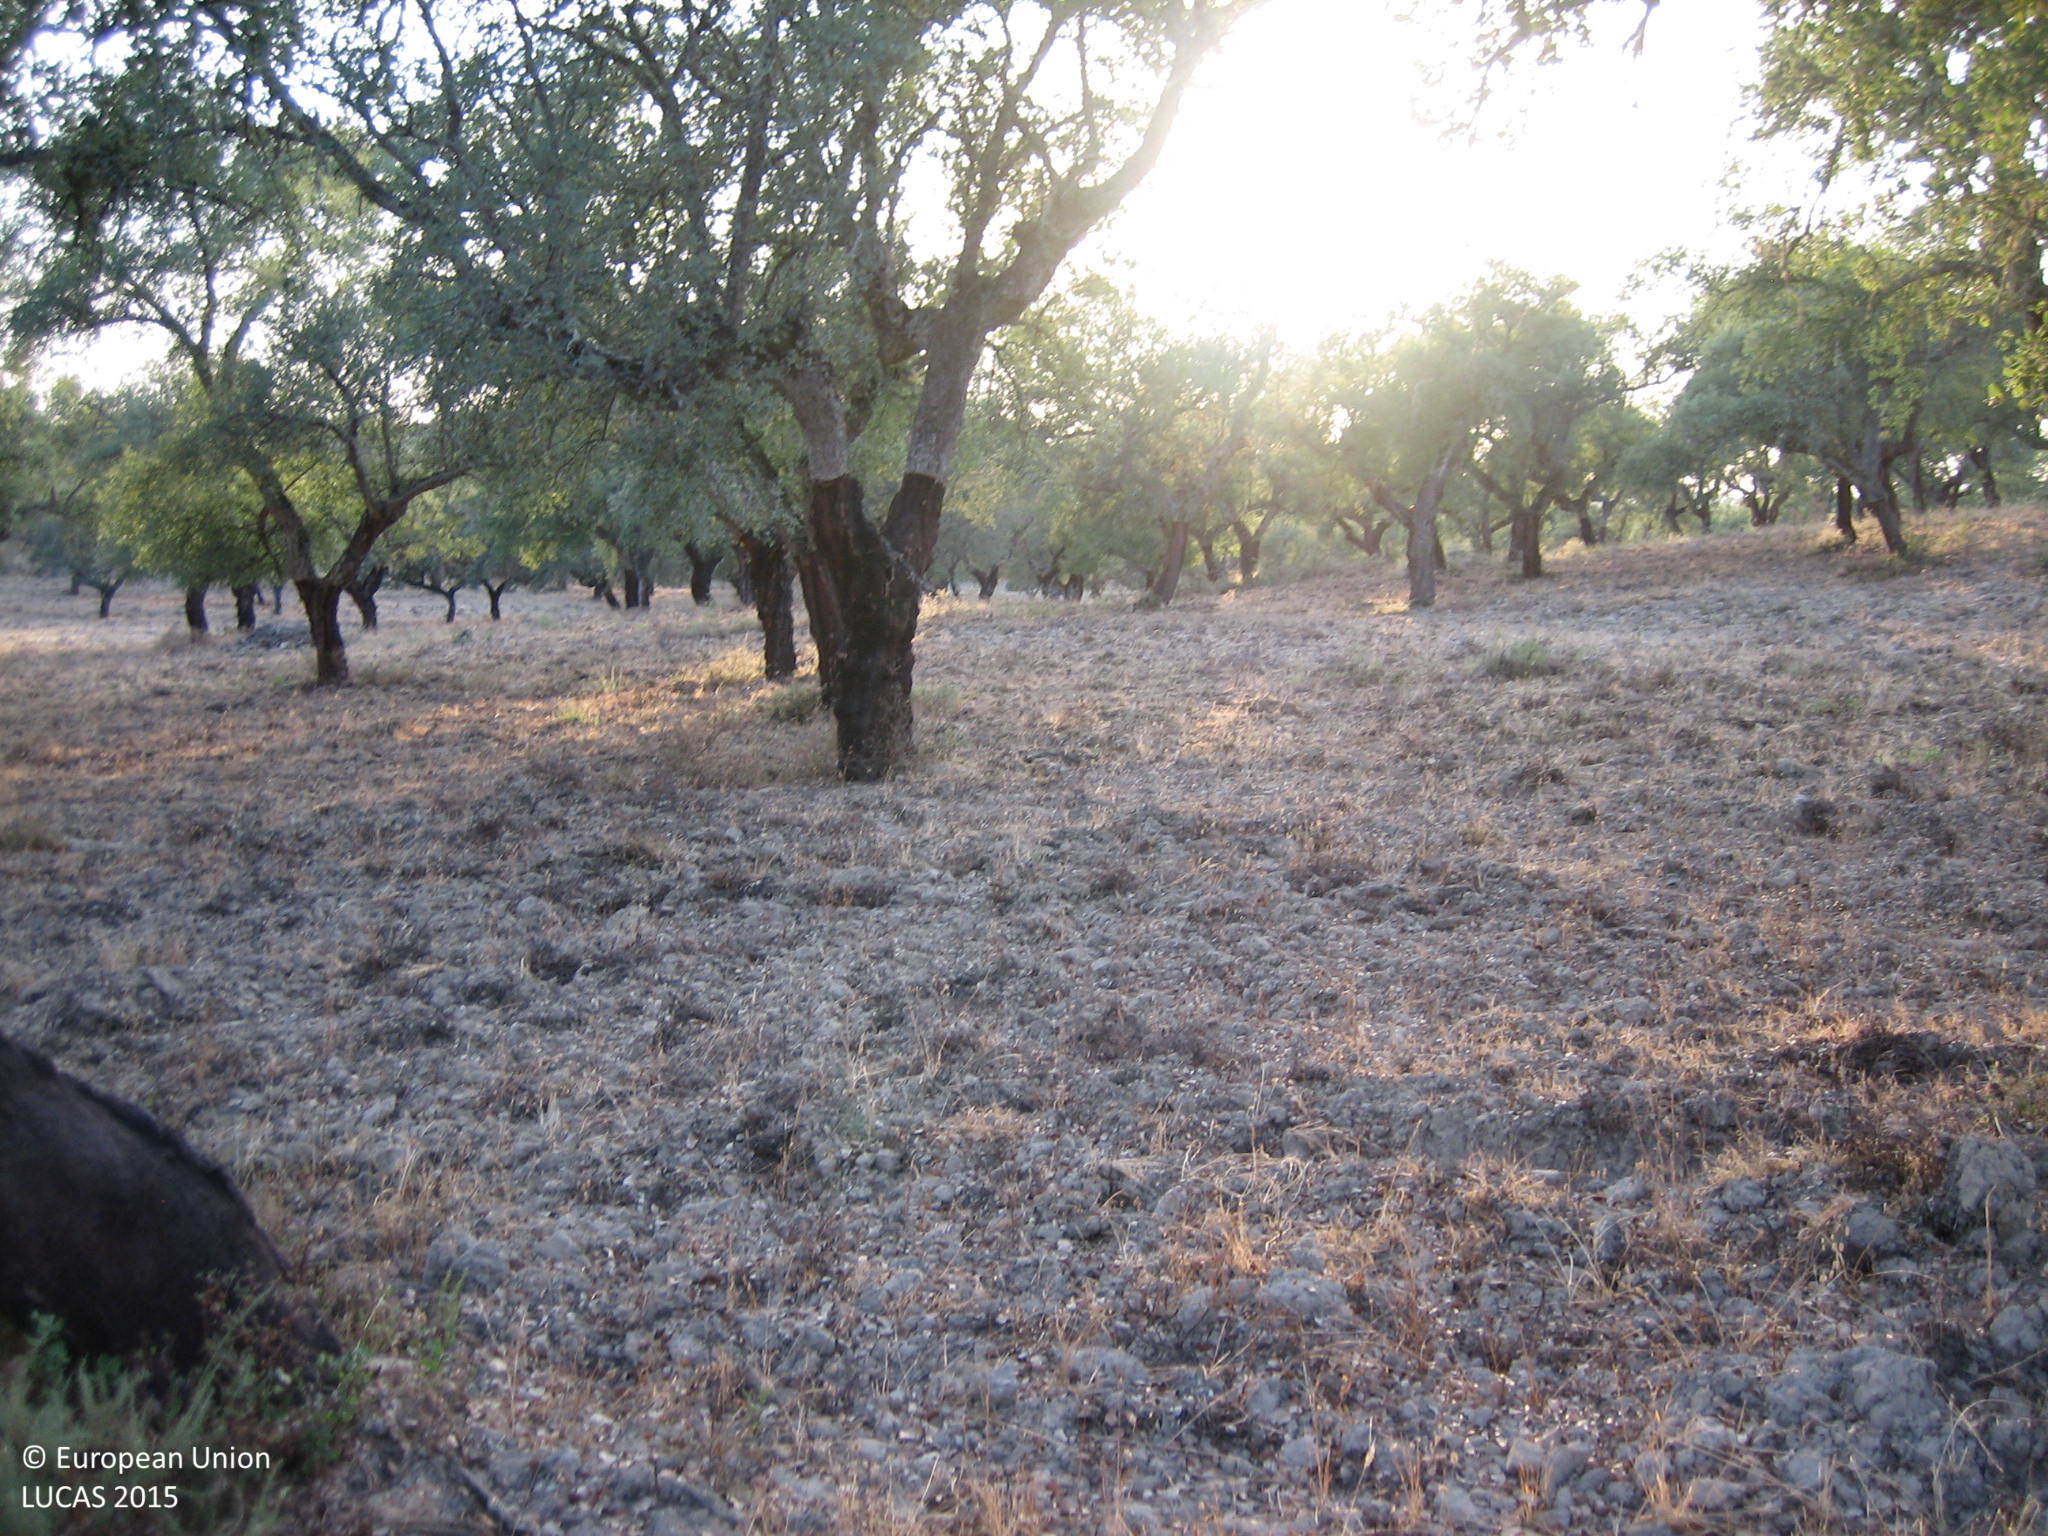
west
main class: Woodland
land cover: Broadleaved woodland
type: broadleaved evergreen forest
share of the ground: 50 - 75 %
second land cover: Grassland without tree/shrub cover
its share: 10 - 25 %
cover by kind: broadleaved forest trees 50 %, unconsolidated bare surface 40 %, herbaceous plants 10 %
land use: Forestry
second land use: Agriculture (excluding fallow land and kitchen gardens)
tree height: > 5 m
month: September
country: ES
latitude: 38.3699
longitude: -6.8722
